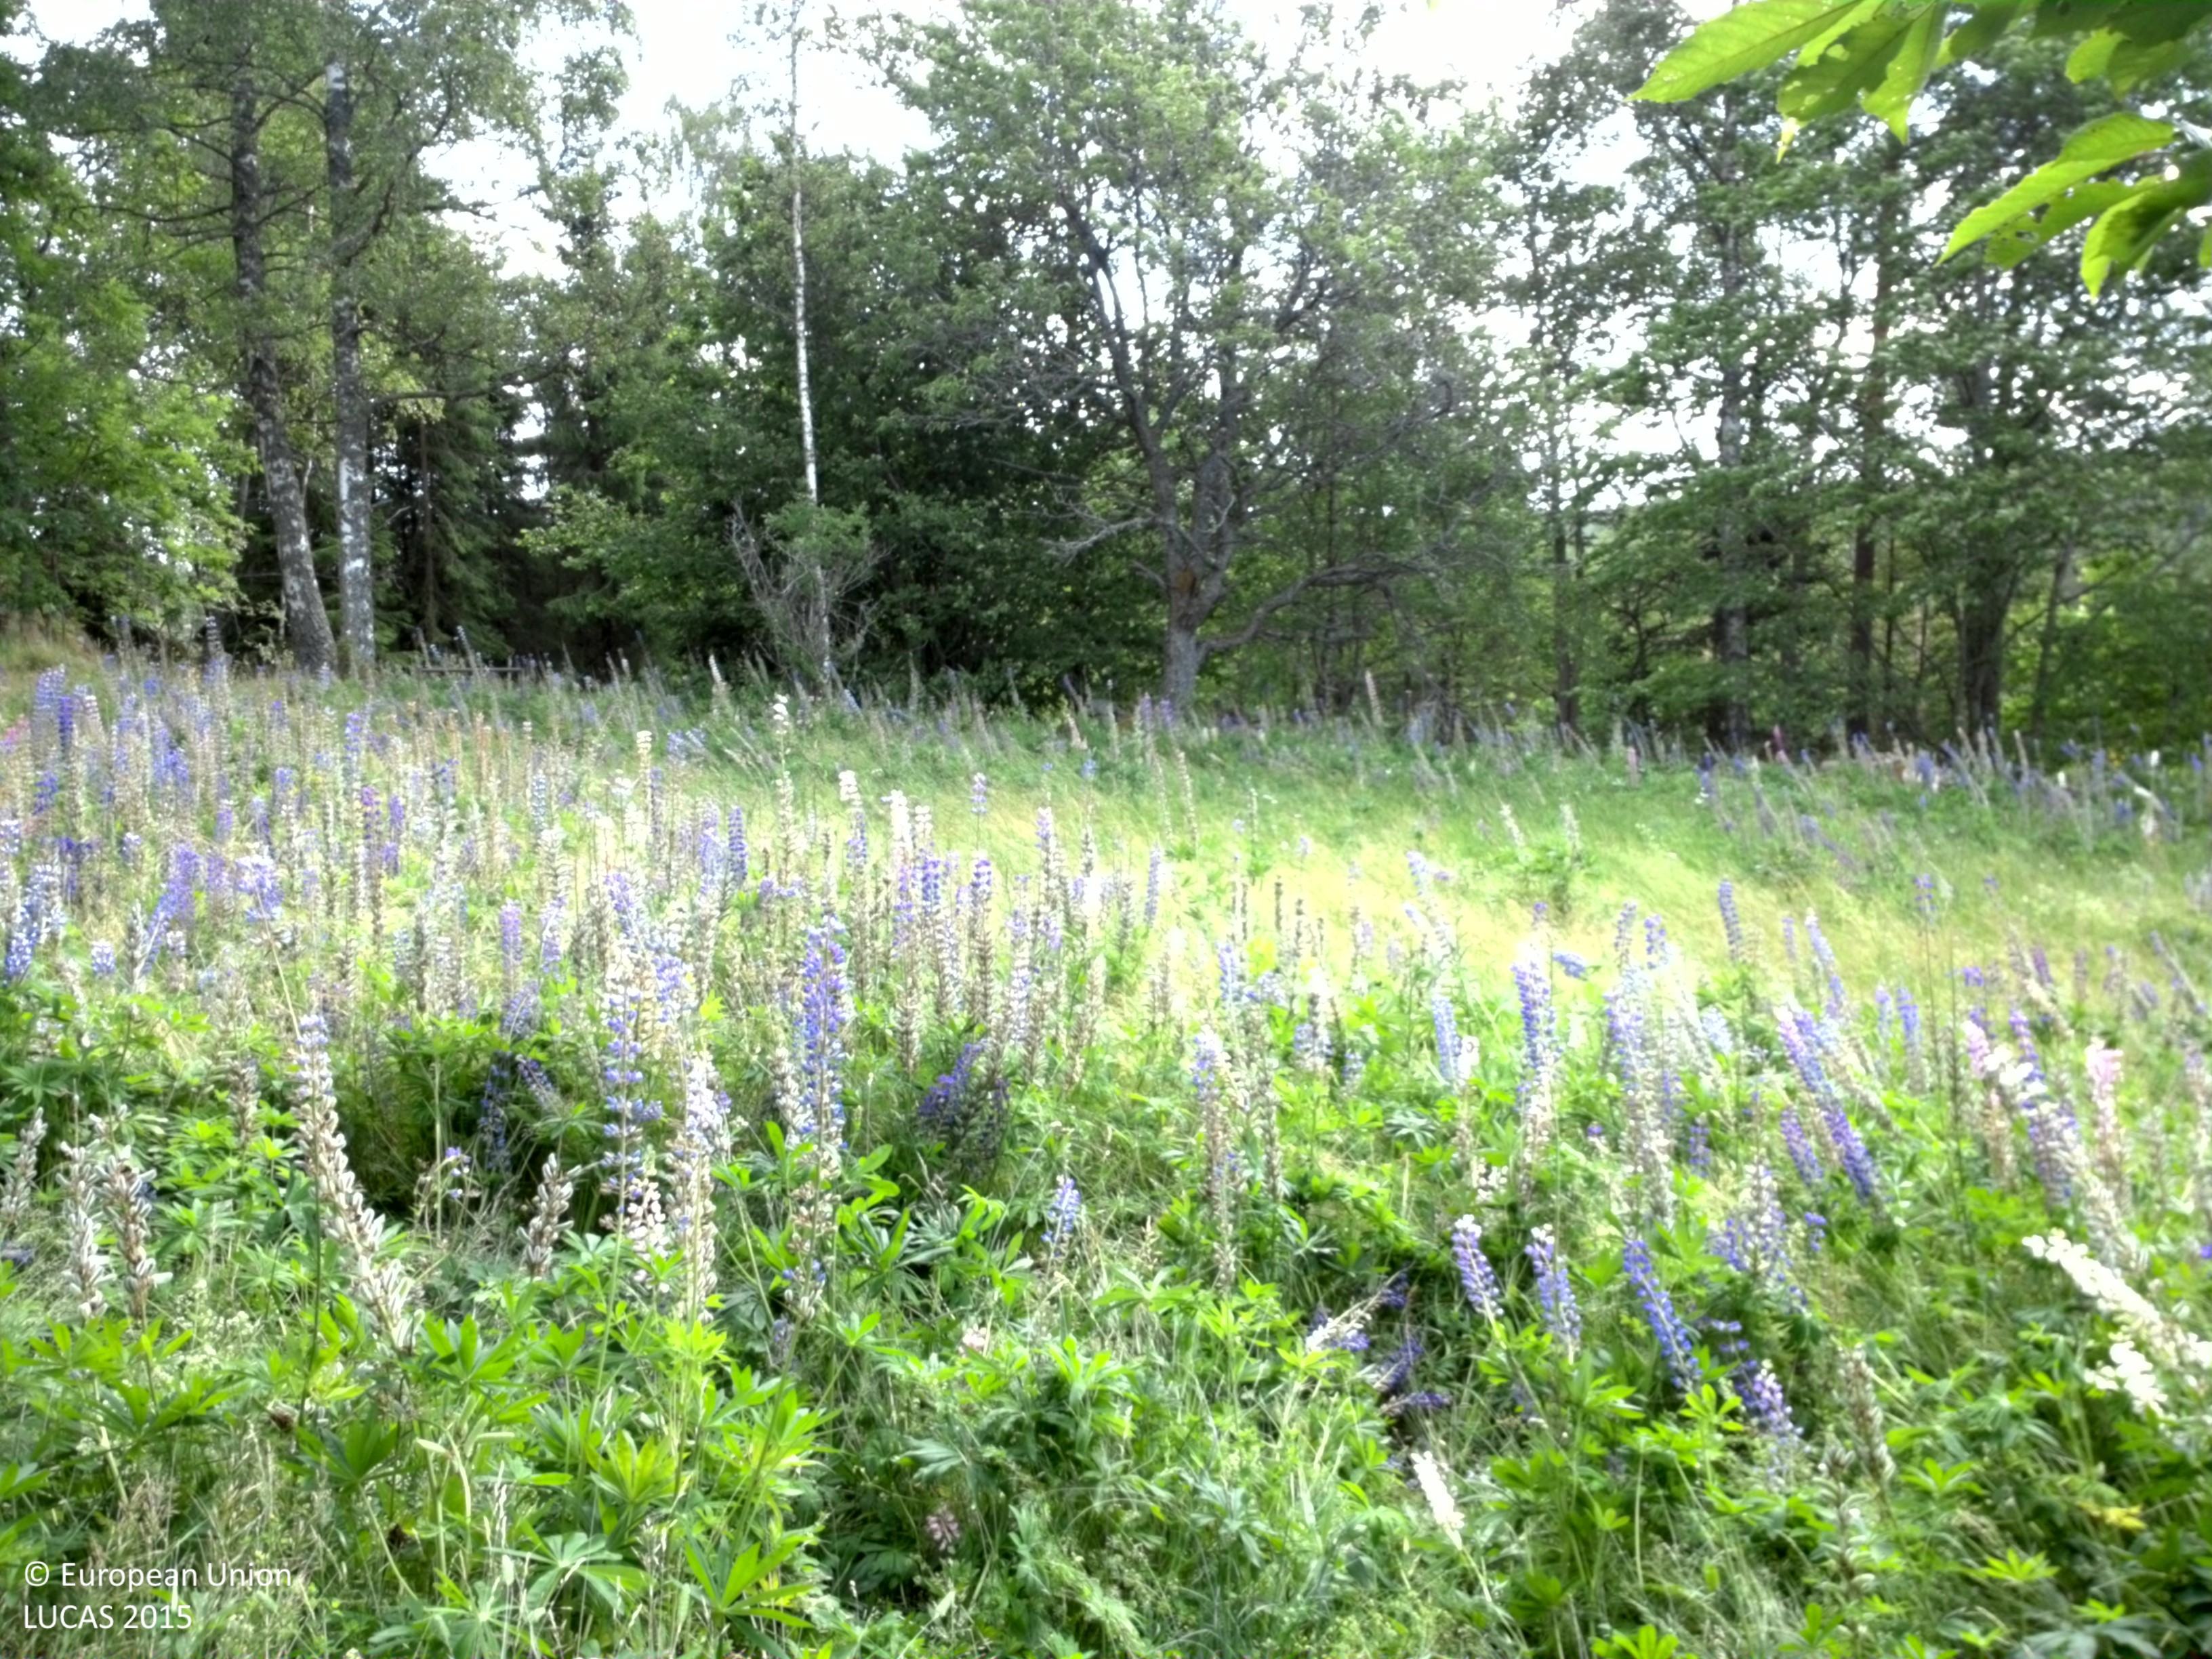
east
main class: Grassland
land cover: Spontaneously vegetated surfaces
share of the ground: > 75 %
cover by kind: herbaceous plants 100 %
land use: Semi-natural and natural areas not in use
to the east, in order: Spontaneously vegetated surfaces; Dry stone walls; Other mixed woodland; Spontaneously vegetated surfaces; Broadleaved woodland; Other mixed woodland; Spruce dominated mixed woodland; Other coniferous woodland; Ditches and canals; Spruce dominated coniferous woodland; Other coniferous woodland
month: July
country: SE
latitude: 58.8251
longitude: 14.6171
